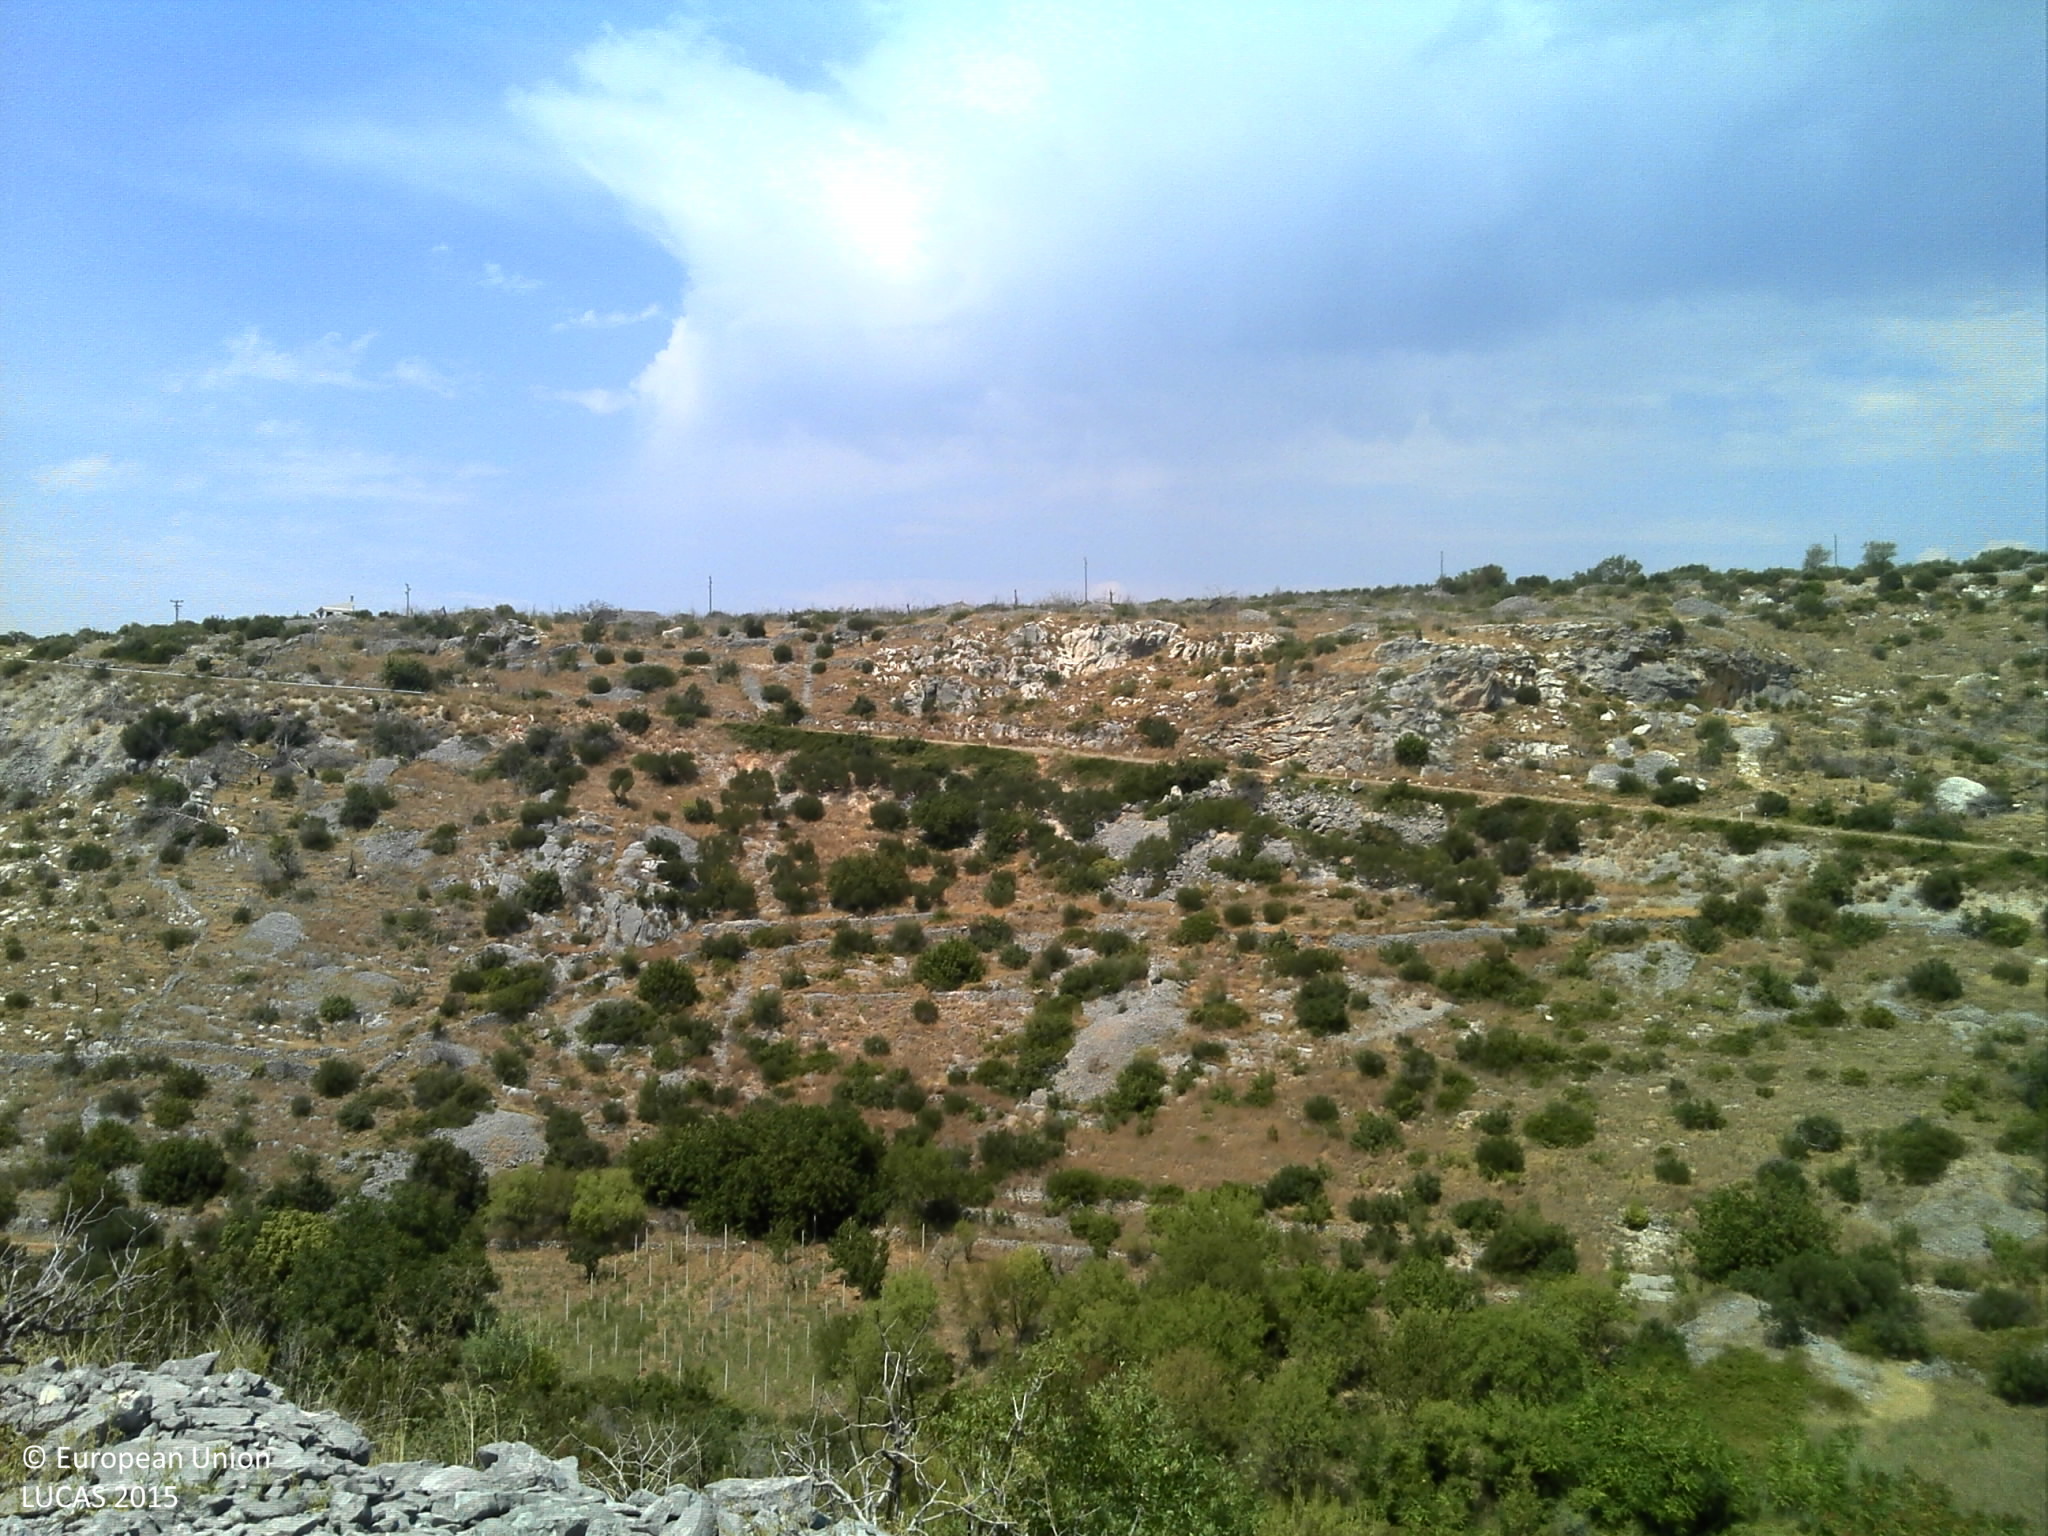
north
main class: Grassland
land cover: Grassland with sparse tree/shrub cover
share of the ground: 50 - 75 %
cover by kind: herbaceous plants 70 %, shrubs 10 %, consolidated bare surface 10 %, broadleaved forest trees 5 %, unconsolidated bare surface 5 %
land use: Abandoned areas
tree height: < 5 m
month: July
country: HR
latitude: 43.3526
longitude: 16.4673
